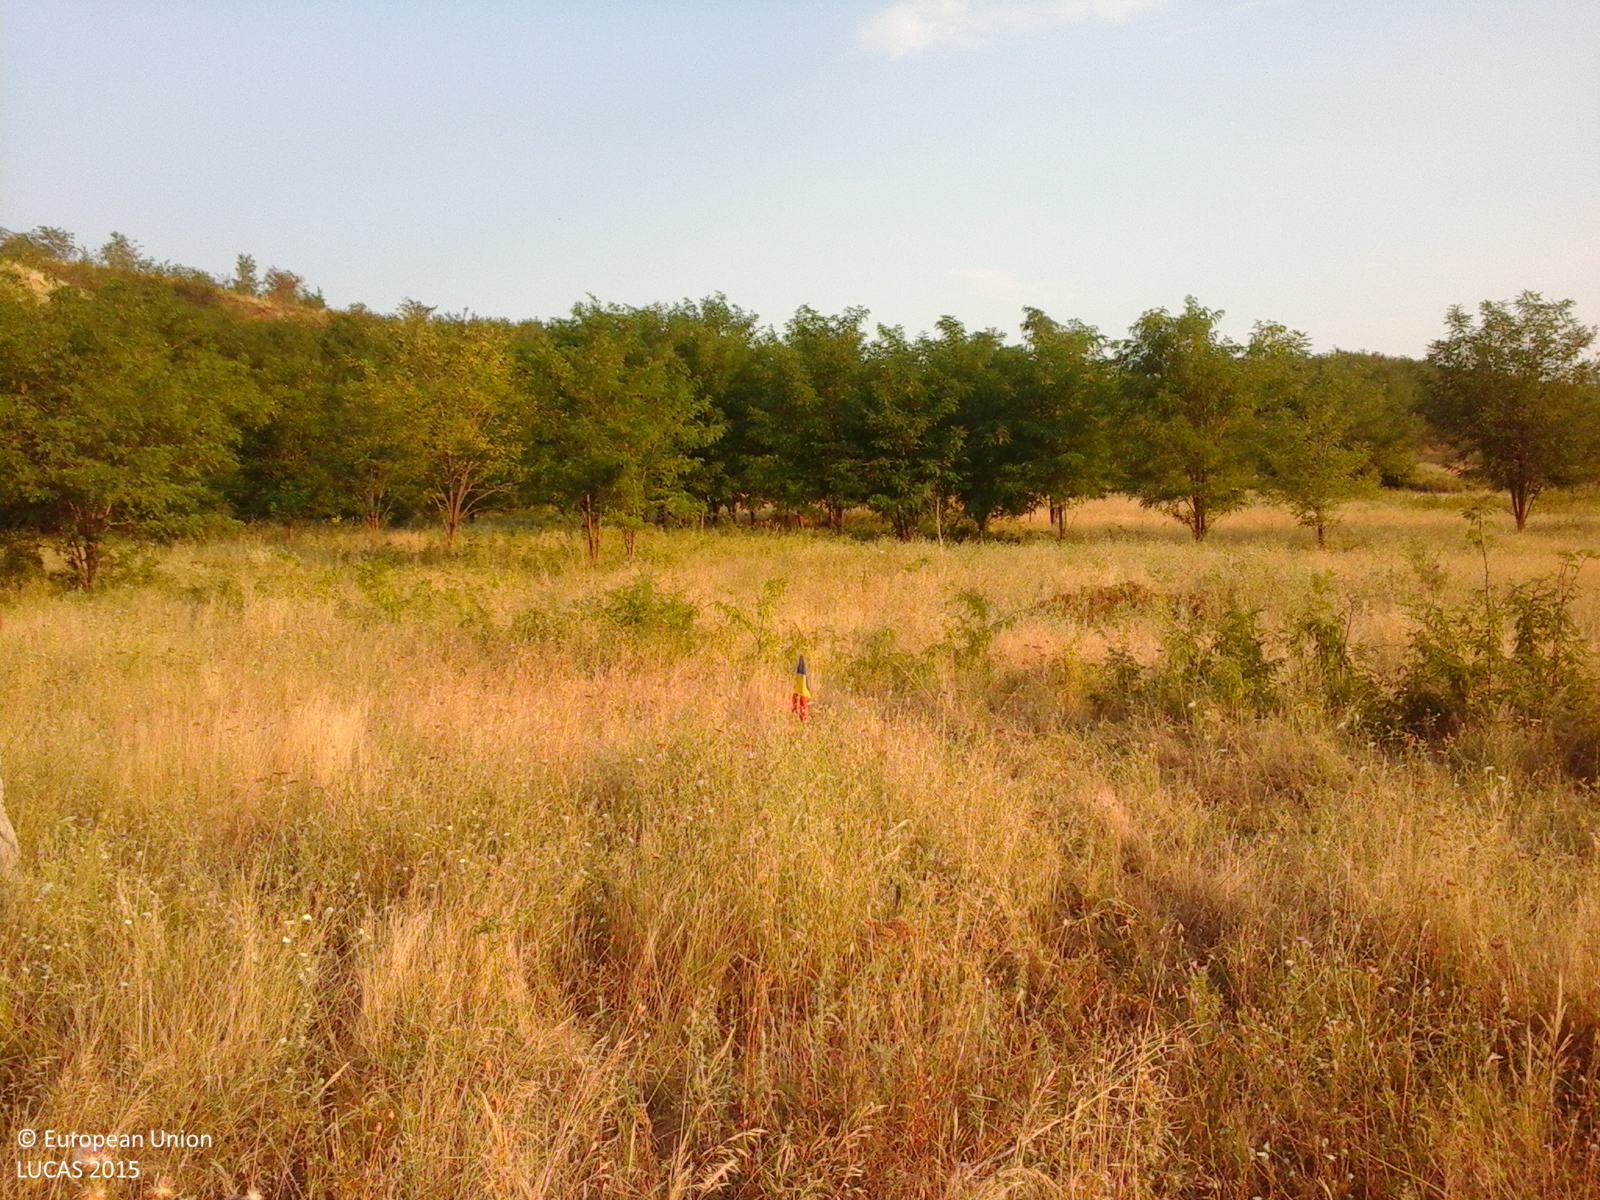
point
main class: Grassland
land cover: Grassland with sparse tree/shrub cover
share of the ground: > 75 %
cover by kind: herbaceous plants 90 %, broadleaved forest trees 5 %, shrubs 5 %
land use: Semi-natural and natural areas not in use
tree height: < 5 m
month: August
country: RO
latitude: 44.4206
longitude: 23.0196
